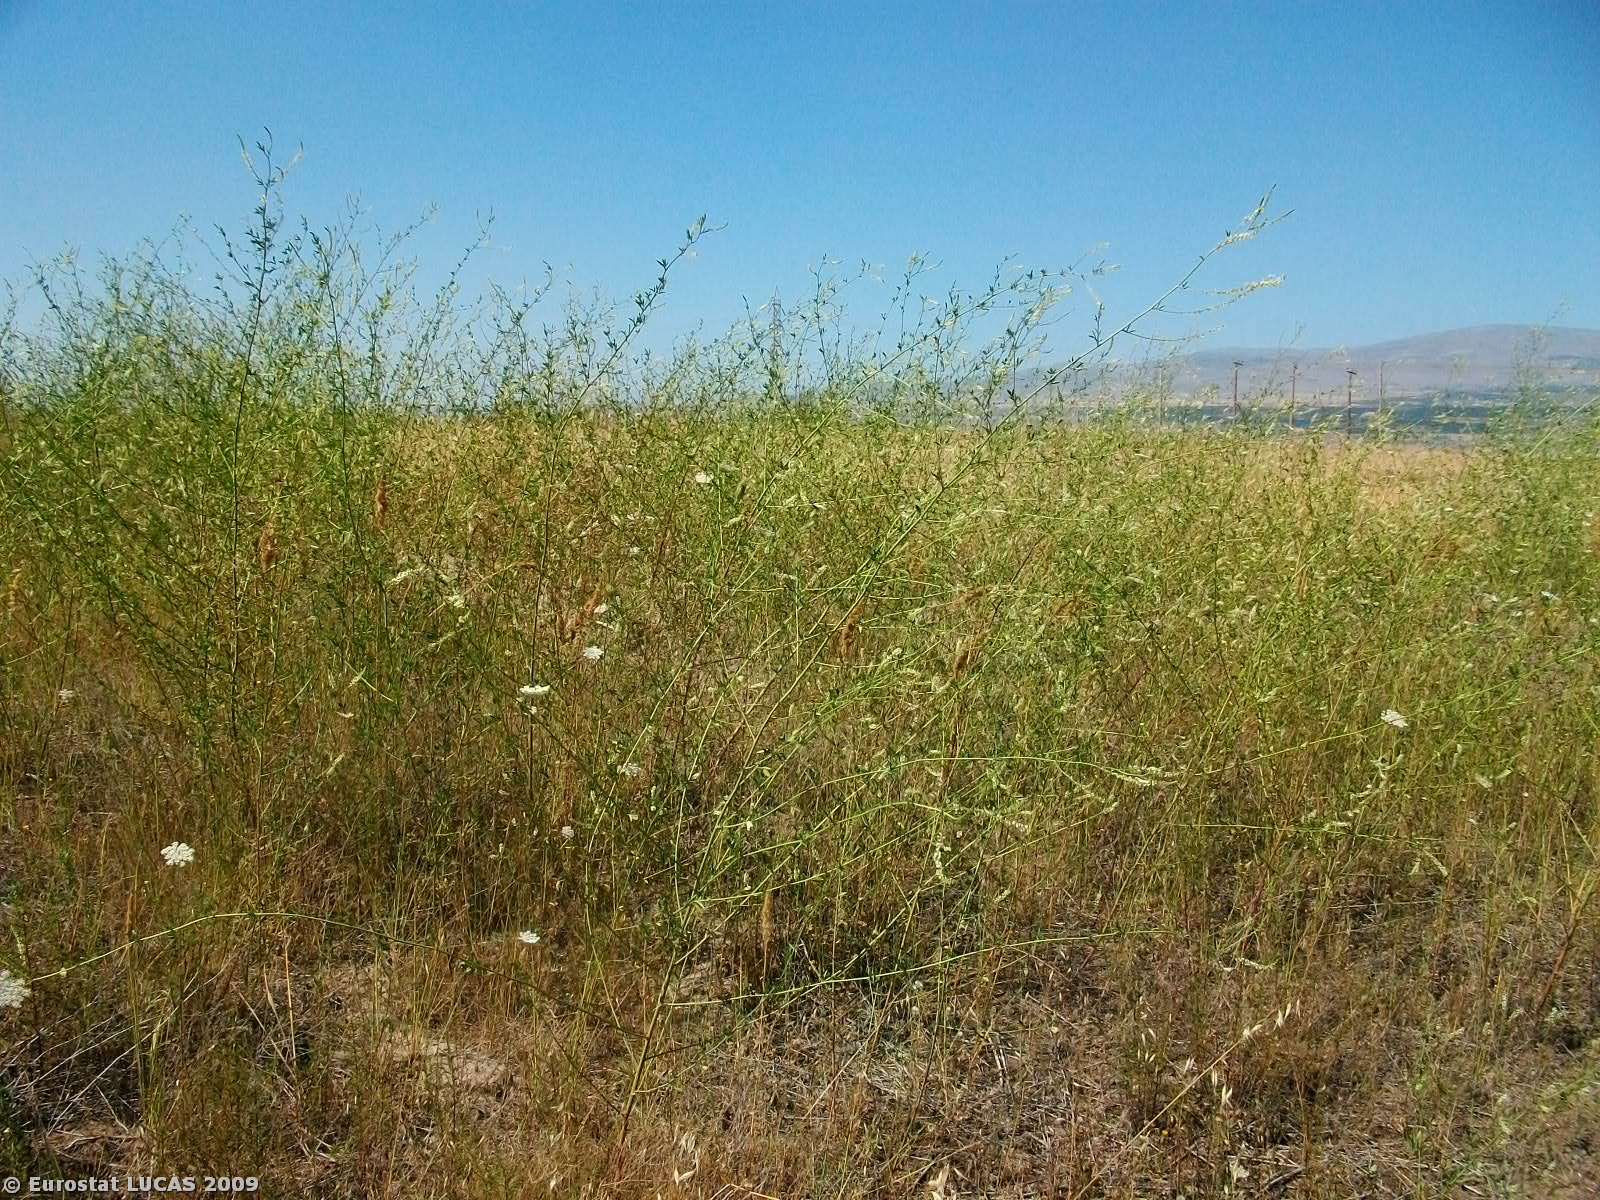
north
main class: Grassland
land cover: Grassland without tree/shrub cover
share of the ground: 50 - 75 %
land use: Unused
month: July
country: GR
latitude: 40.4122
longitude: 21.7893
